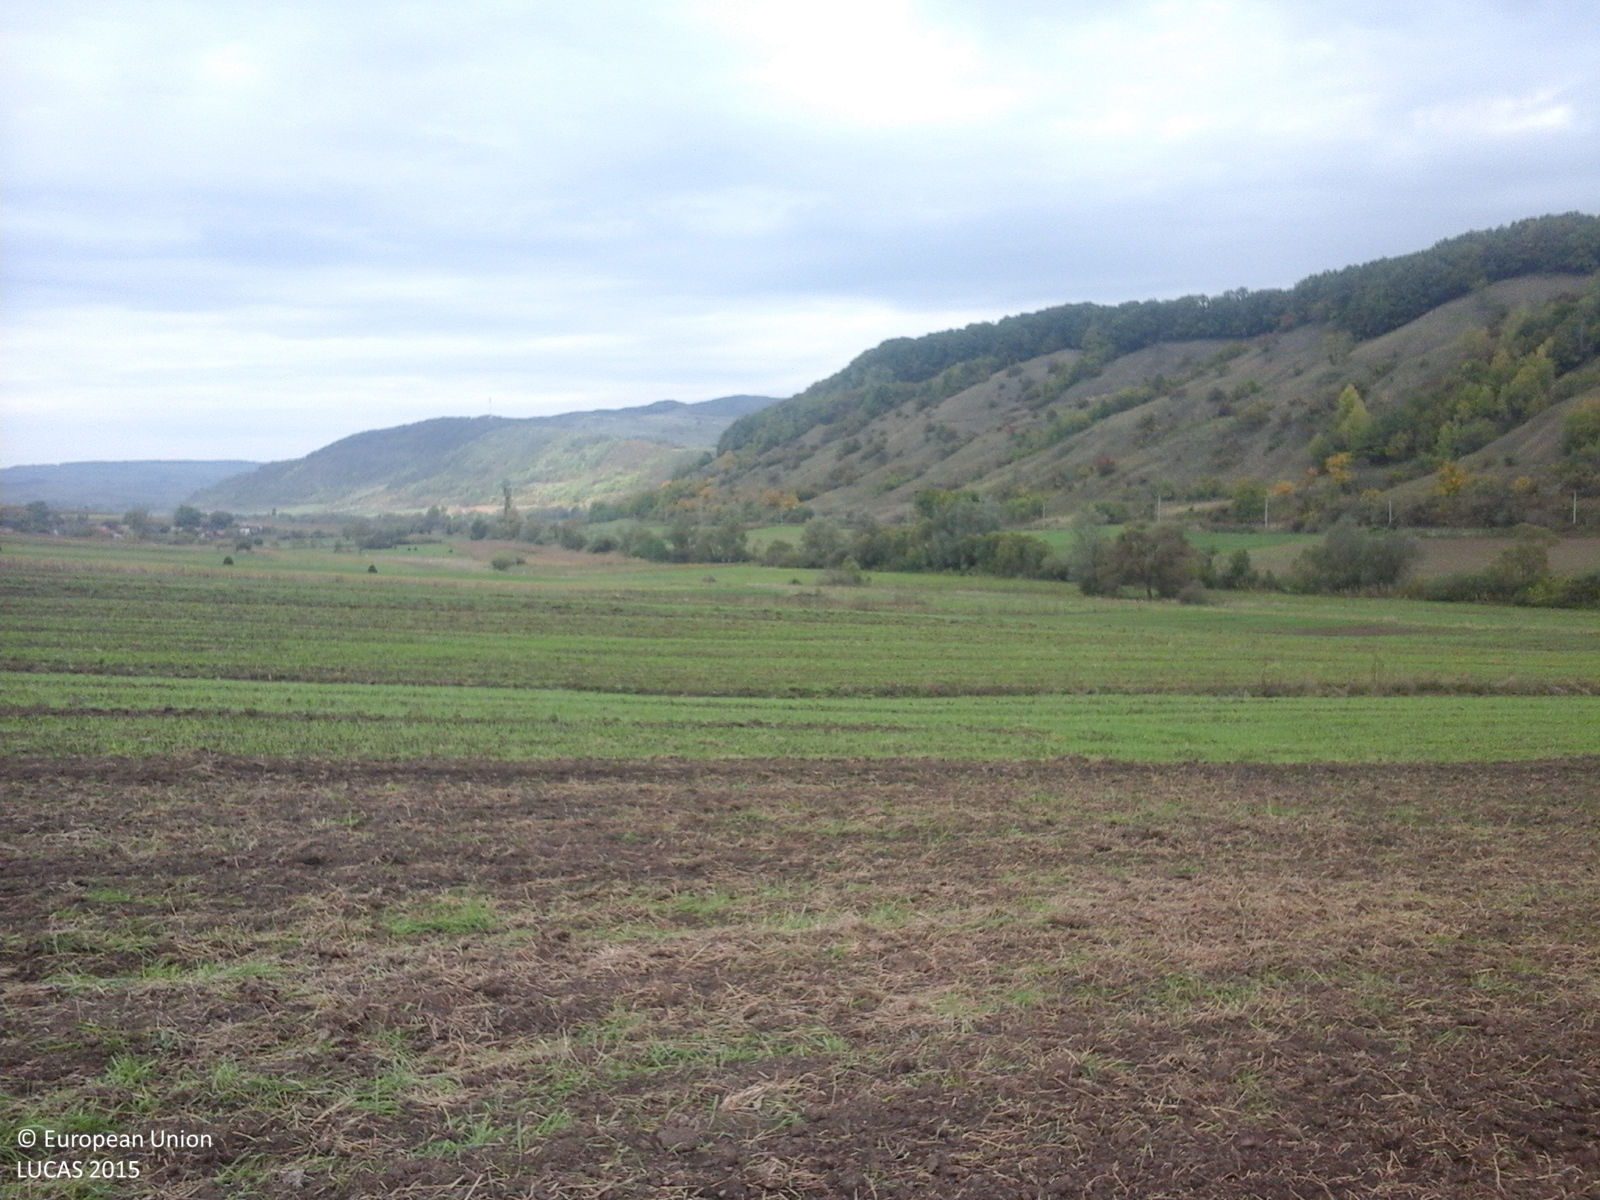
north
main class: Cropland
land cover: Common wheat
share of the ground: < 10 %
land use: Agriculture (excluding fallow land and kitchen gardens)
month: October
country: RO
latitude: 46.5453
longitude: 24.8971
